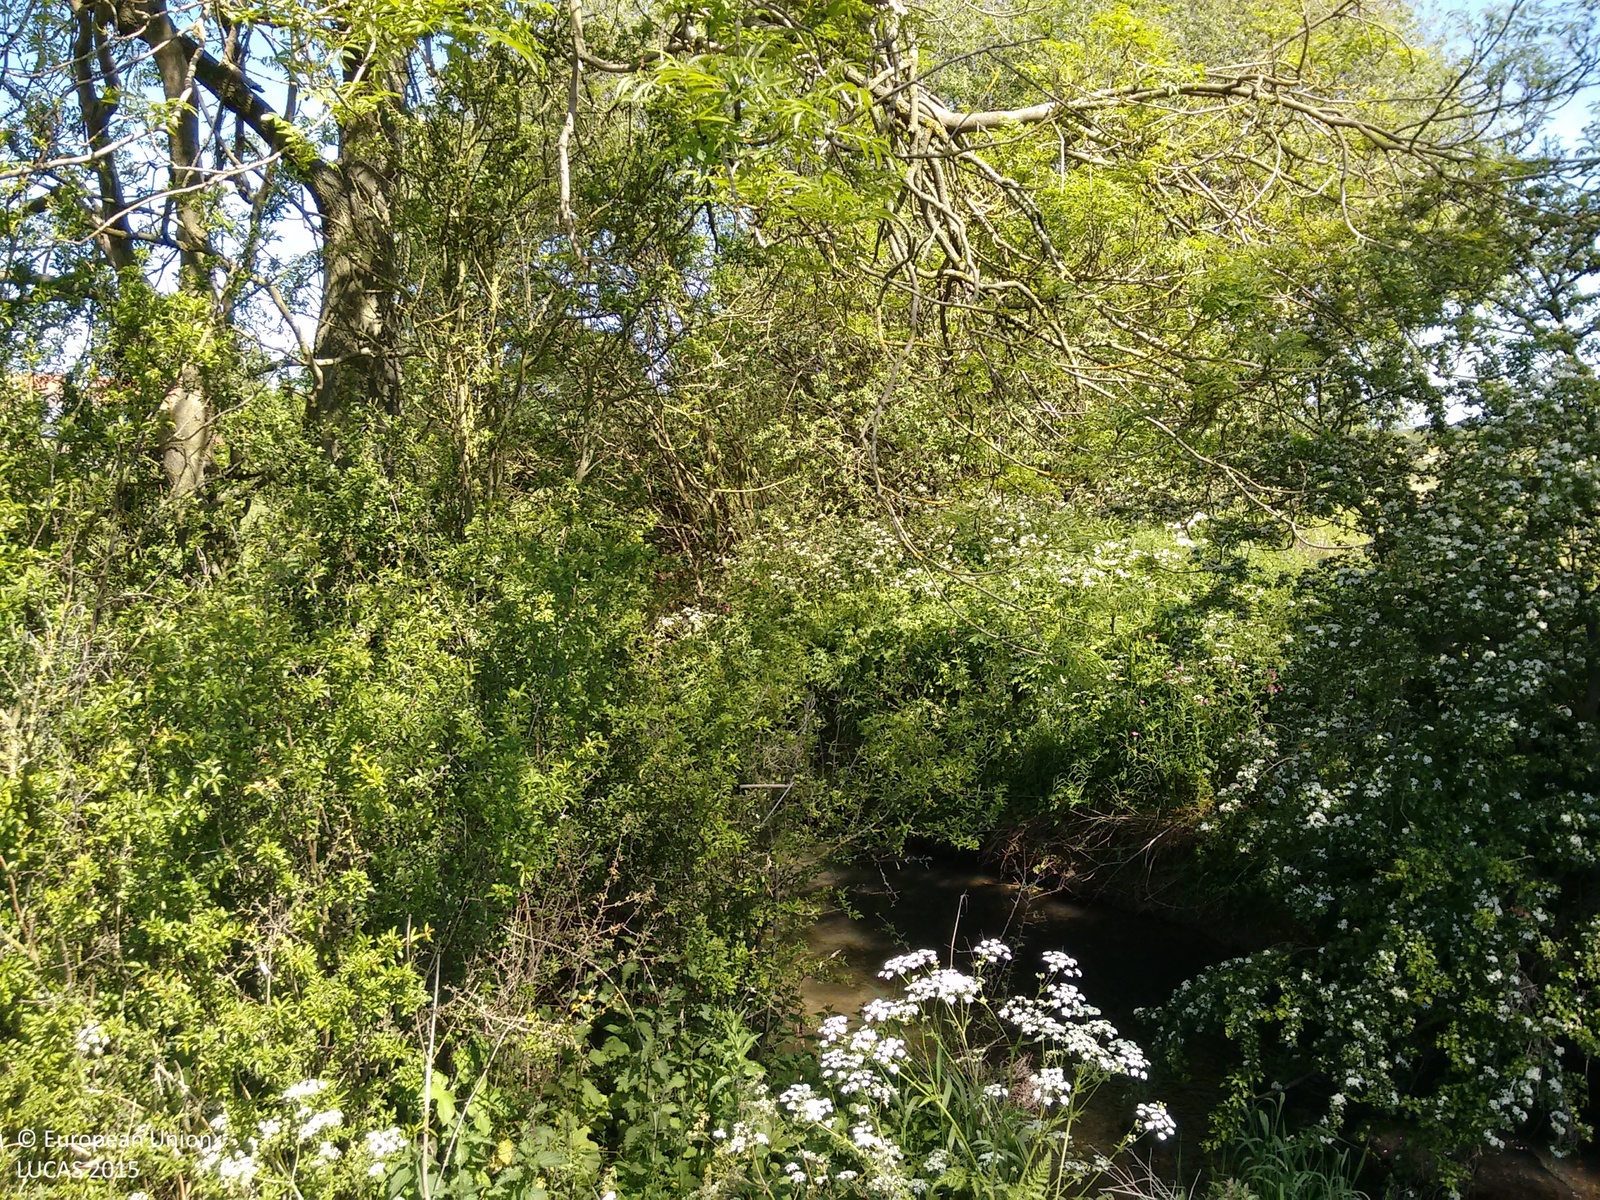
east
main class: Grassland
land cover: Spontaneously vegetated surfaces
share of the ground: > 75 %
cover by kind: herbaceous plants 100 %
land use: Agriculture (excluding fallow land and kitchen gardens)
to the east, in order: Spontaneously vegetated surfaces; Potatoes; Spontaneously vegetated surfaces; Broadleaved woodland; Rivers and streams; Grassland without tree/shrub cover; Fences; Spontaneously vegetated surfaces; Electric lines; Spontaneously vegetated surfaces
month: June
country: GB
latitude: 54.0693
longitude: -0.9062
